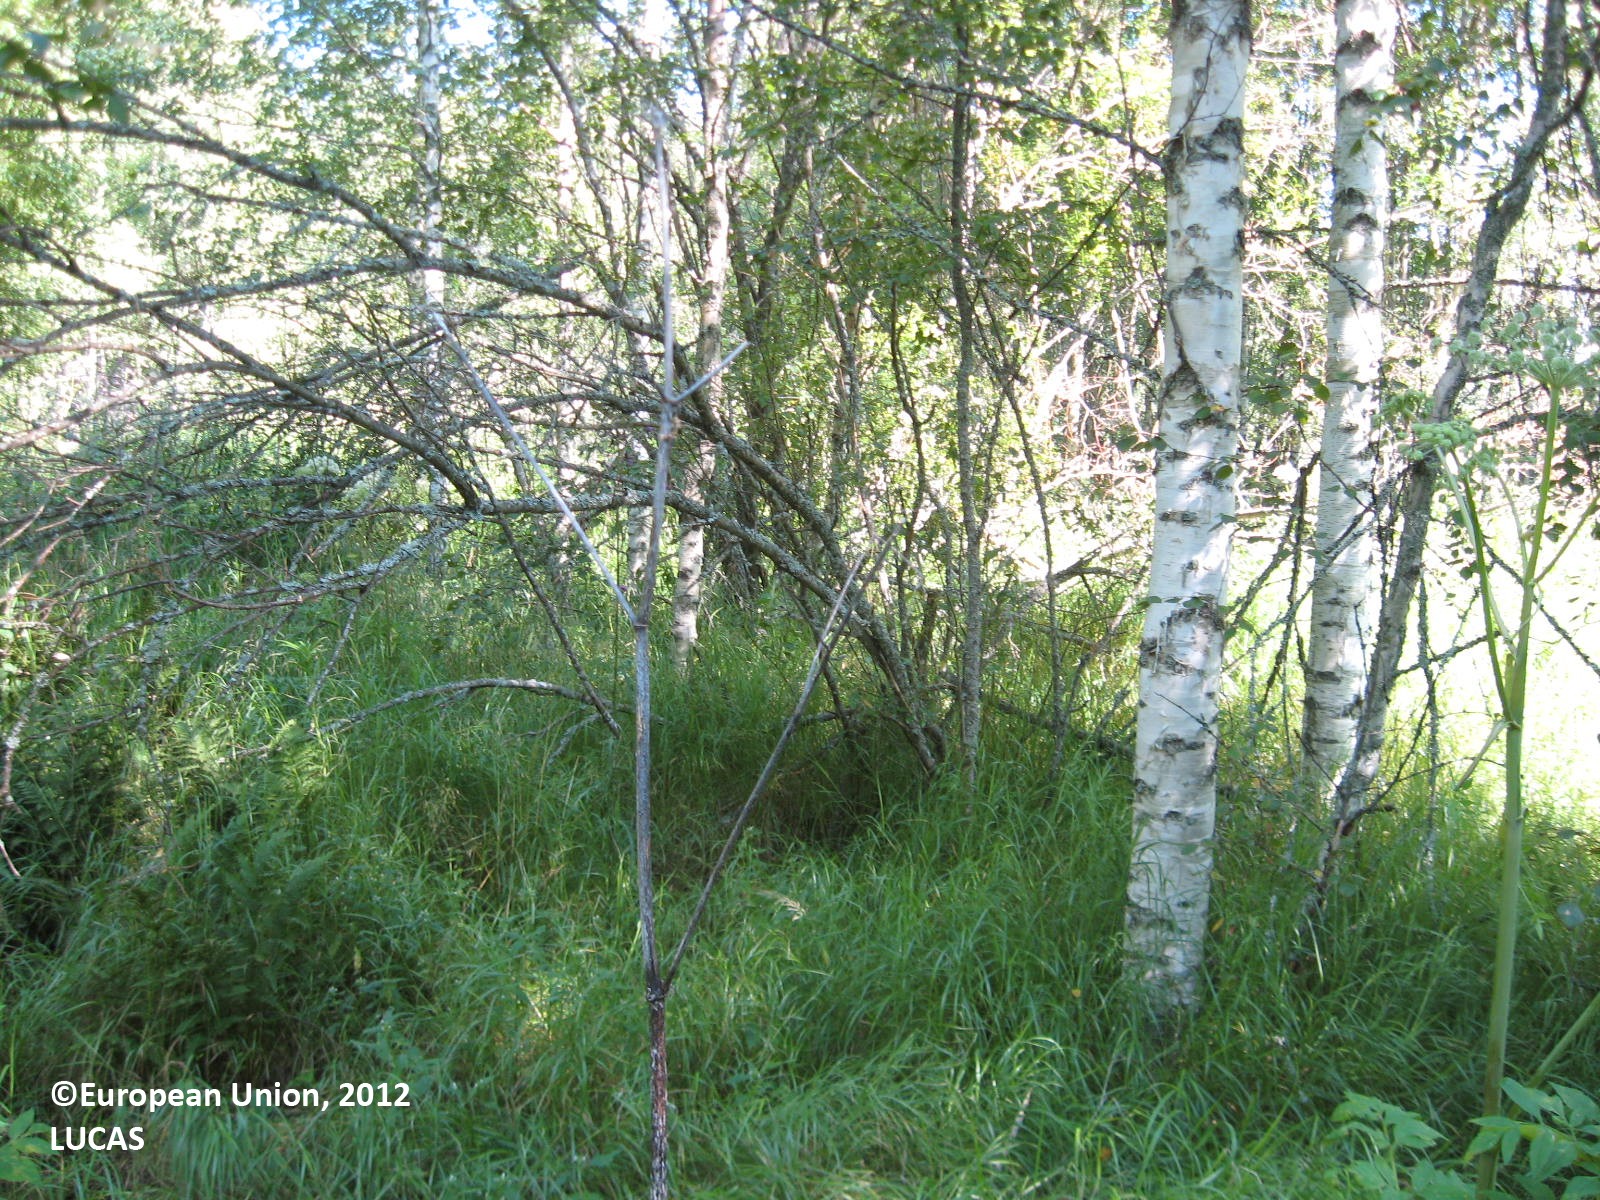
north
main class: Woodland
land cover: Broadleaved woodland
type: boreal forest
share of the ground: > 75 %
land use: Forestry
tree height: > 5 m
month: July
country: FI
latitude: 61.8700
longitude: 22.7072
